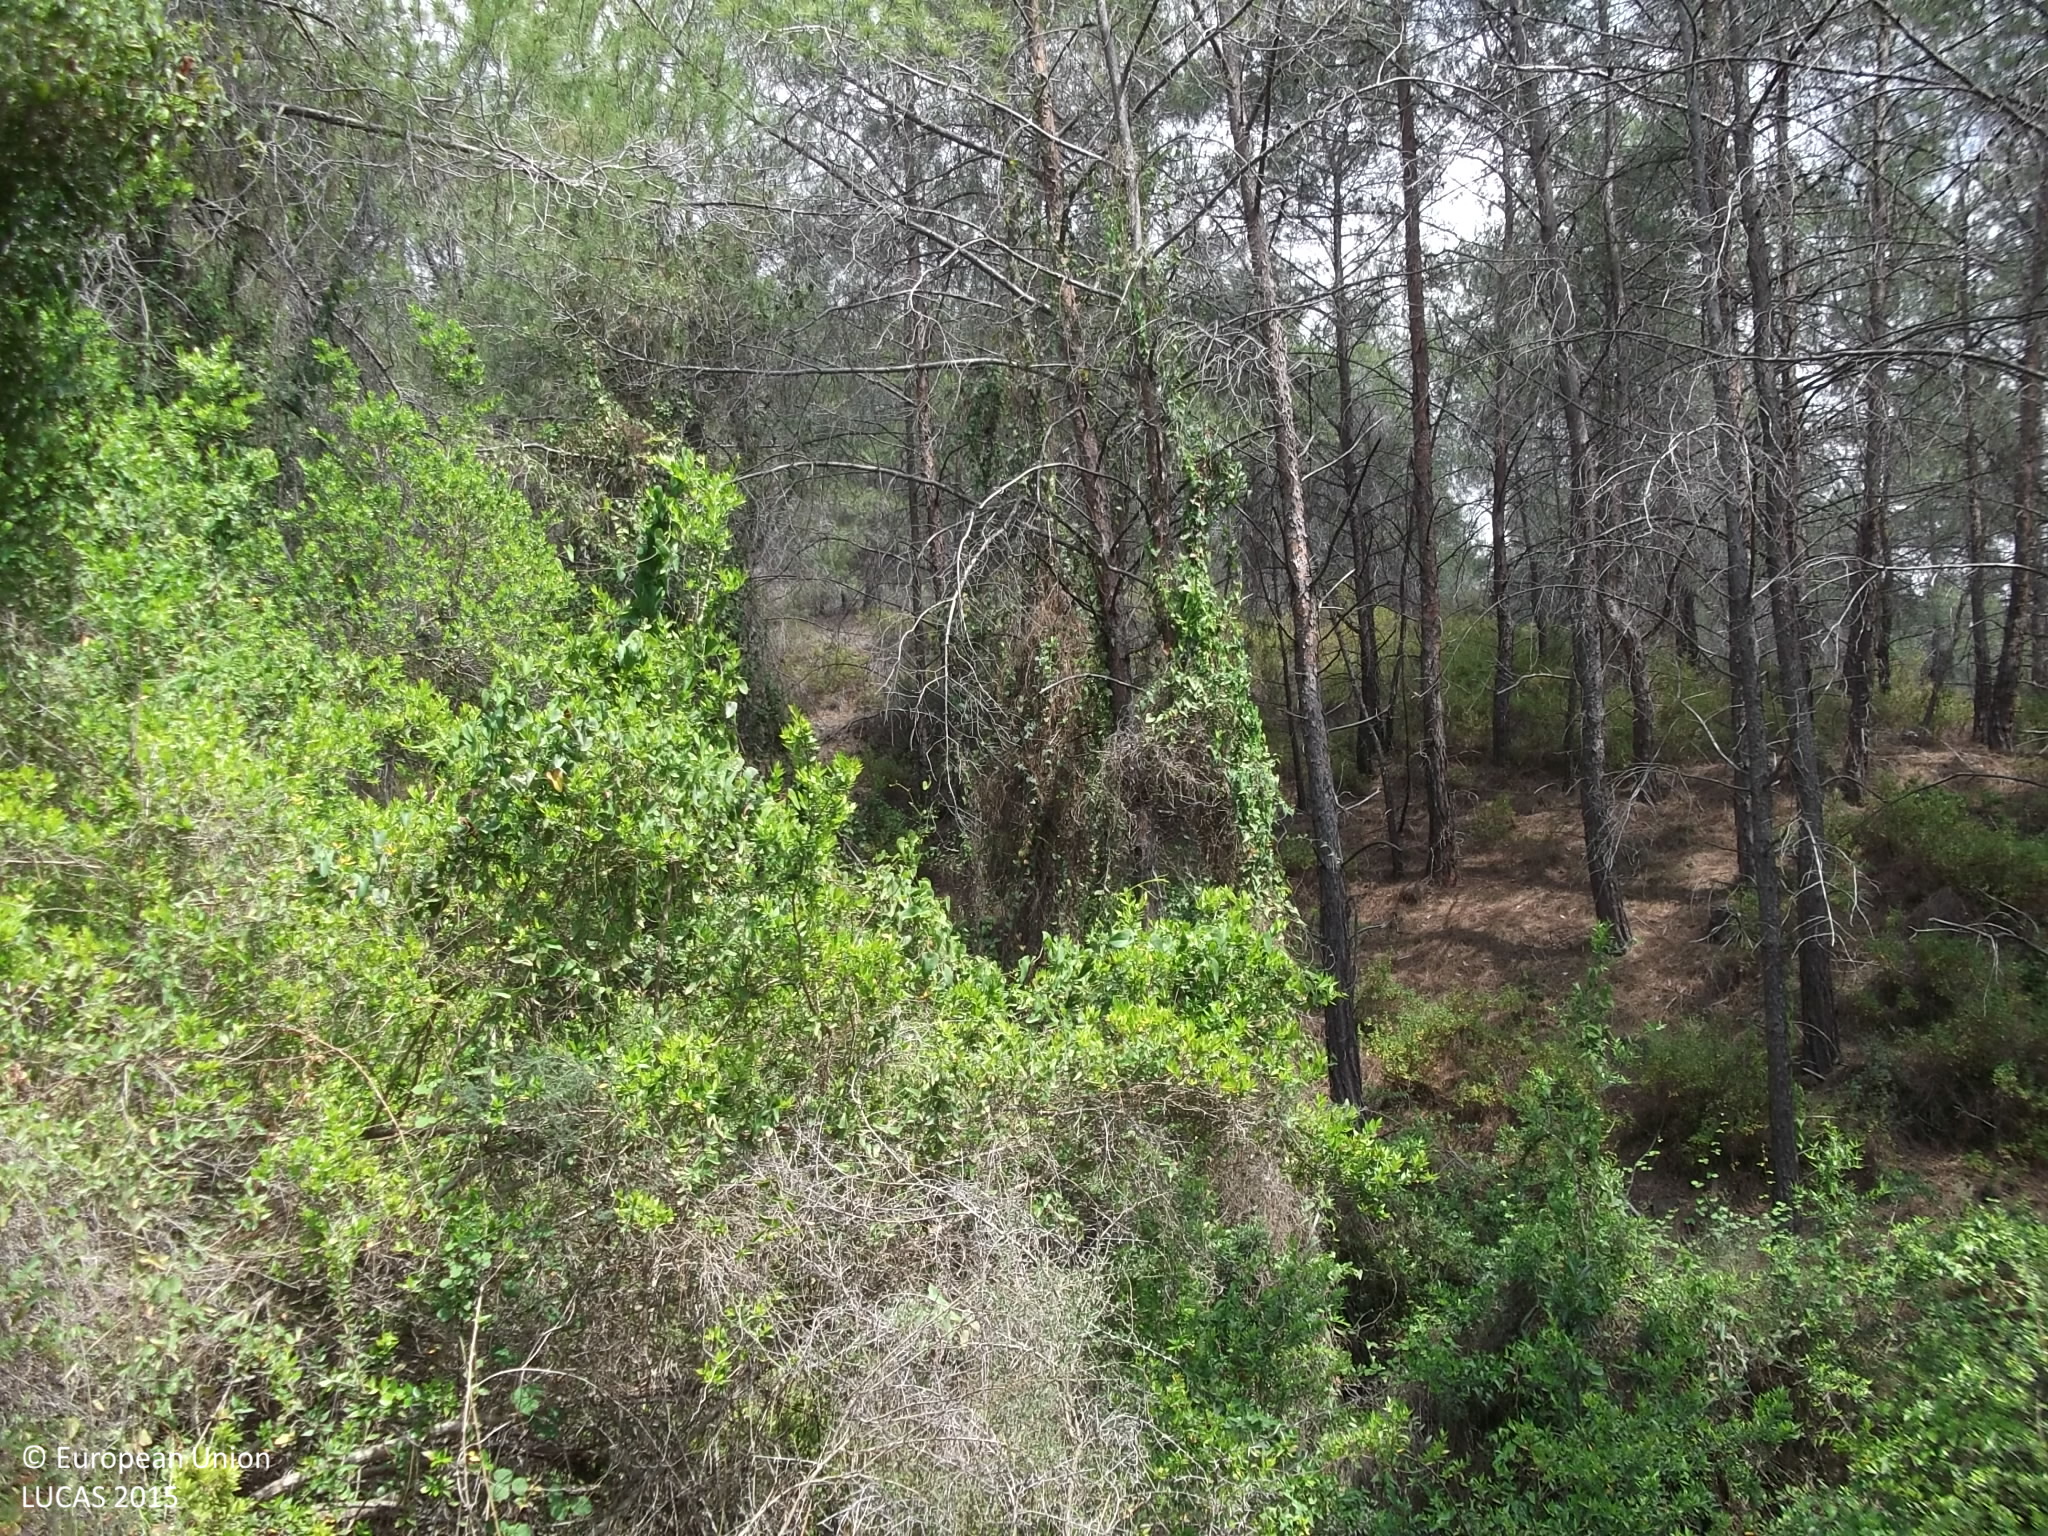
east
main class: Woodland
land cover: Pine dominated coniferous woodland
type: coniferous forest of the mediterranean region
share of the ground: > 75 %
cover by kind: coniferous forest trees 75 %, shrubs 15 %, unconsolidated bare surface 10 %
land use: Semi-natural and natural areas not in use
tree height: > 5 m
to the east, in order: Pine dominated coniferous woodland
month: June
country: CY
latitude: 35.0660
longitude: 32.5165
